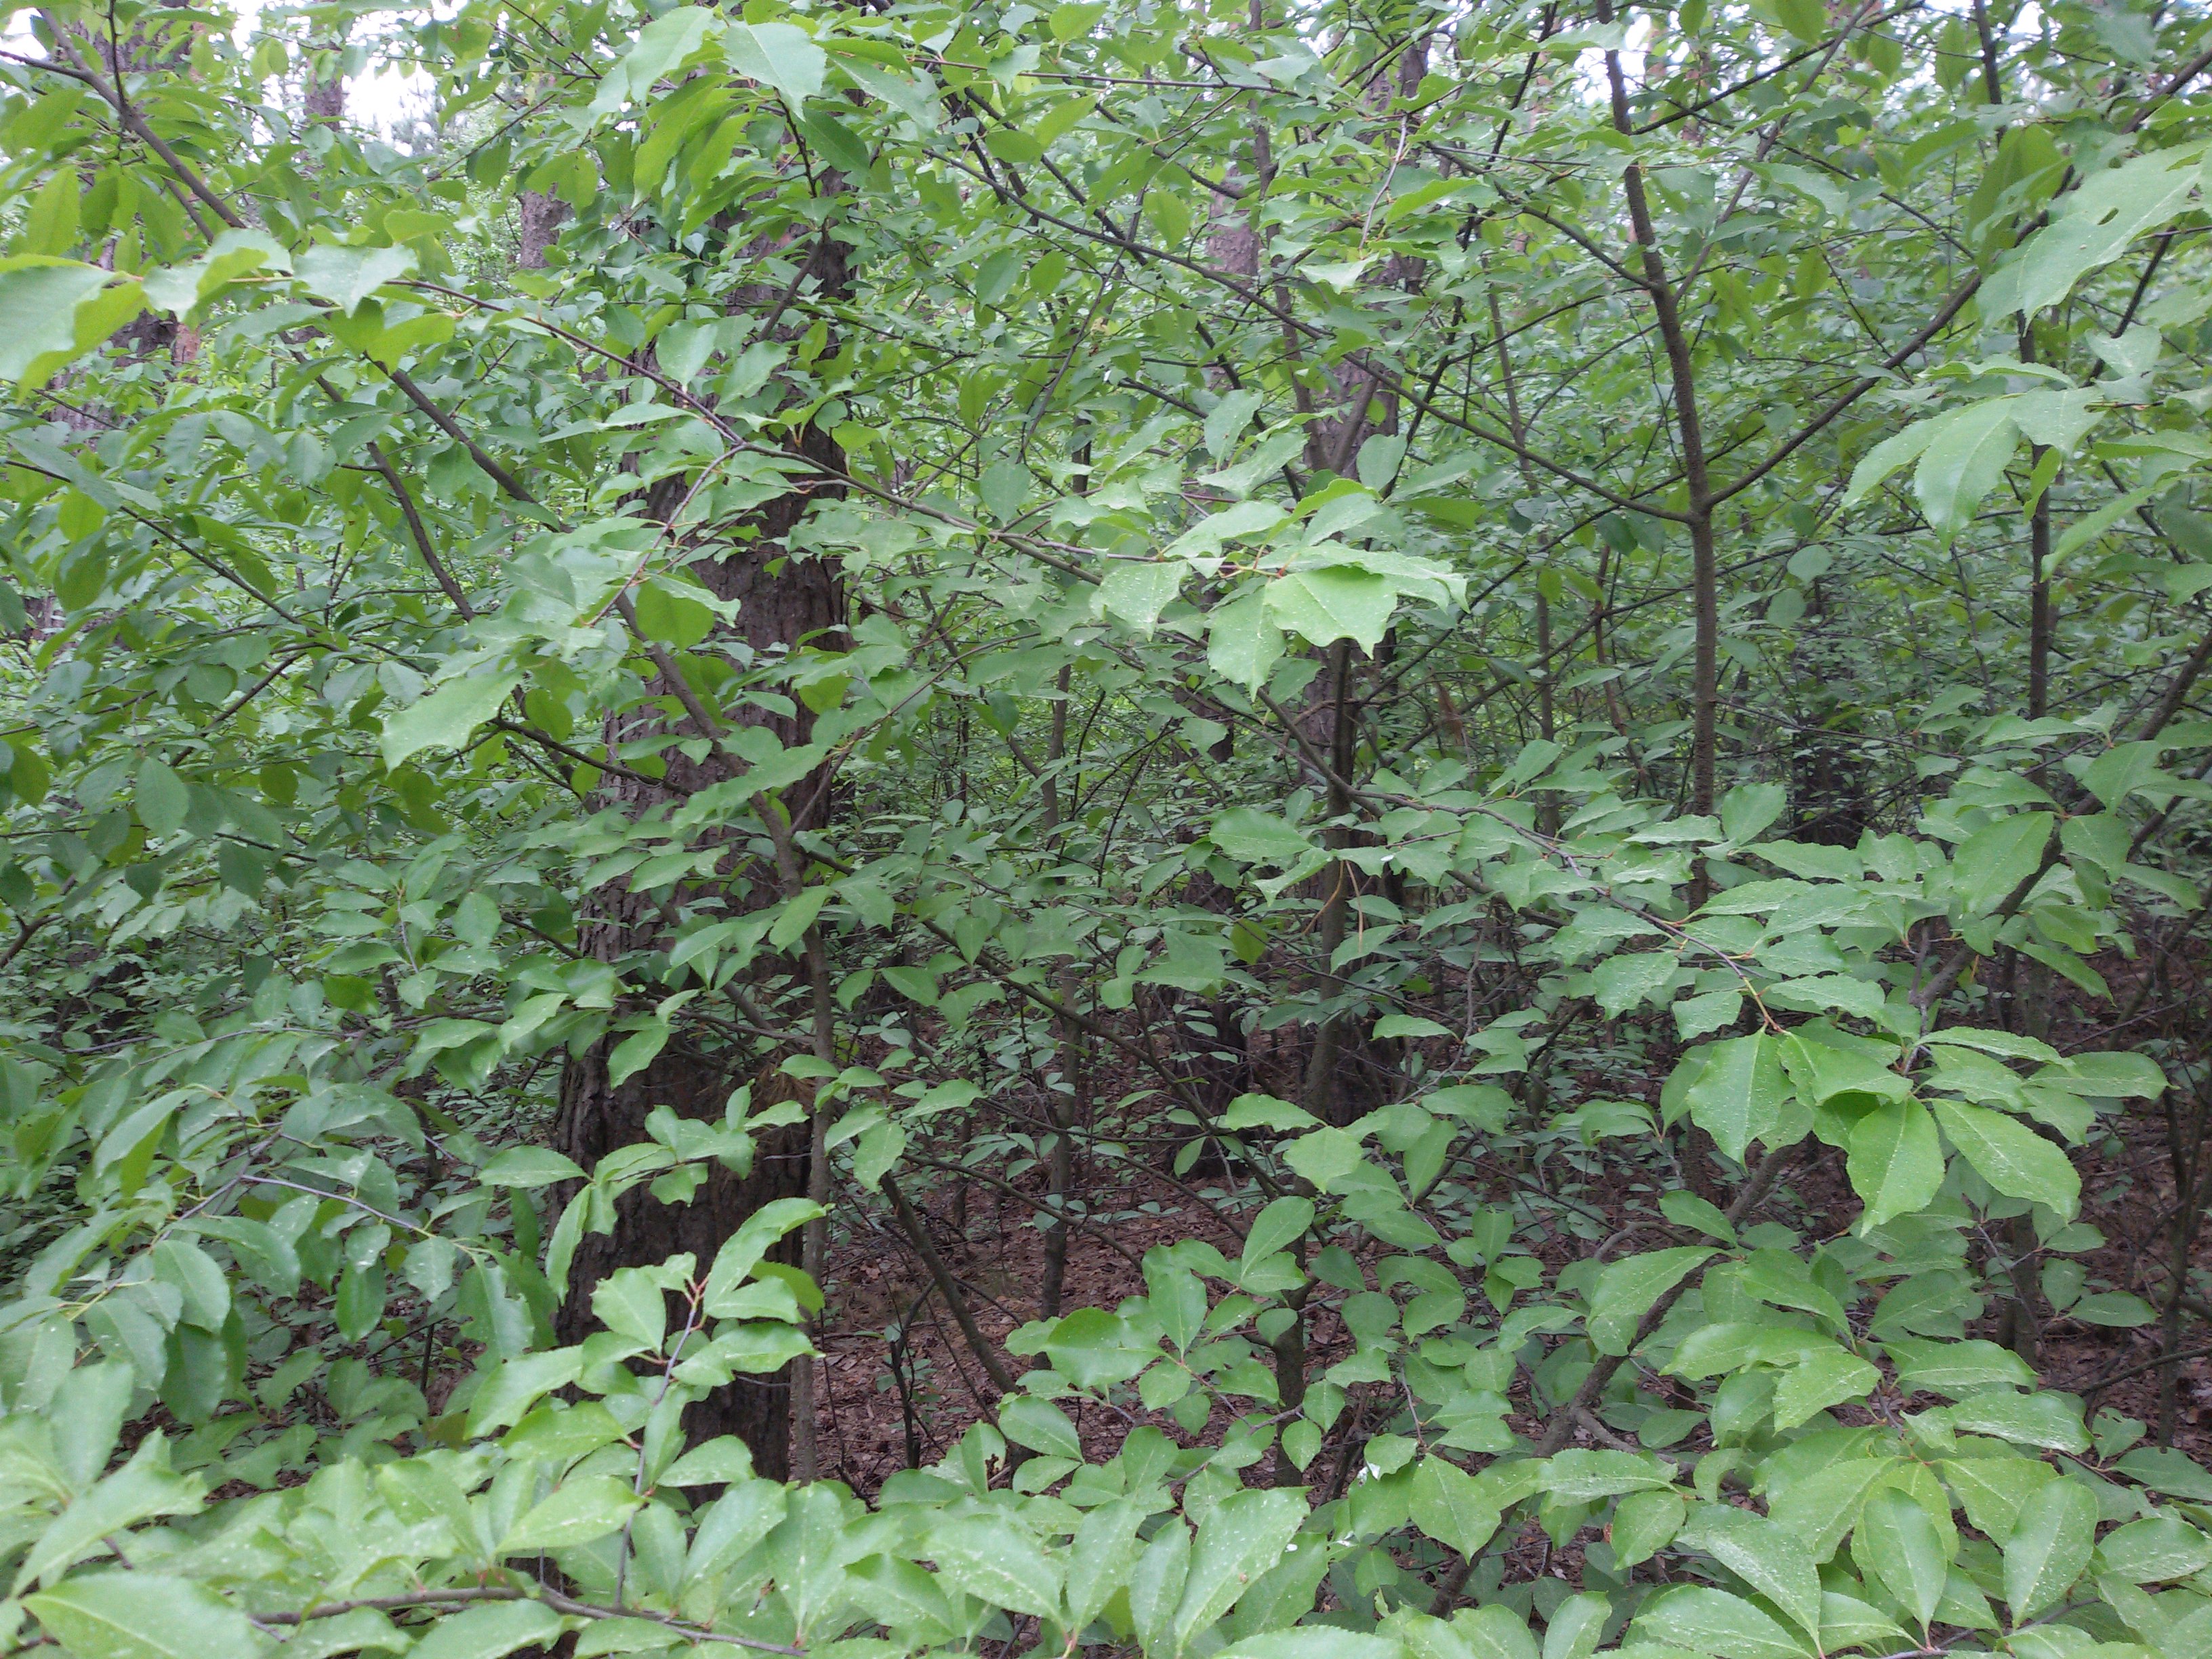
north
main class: Woodland
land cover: Pine dominated coniferous woodland
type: hemiboreal forest and nemoral coniferous forest and mixed broadleaved-coniferous forest
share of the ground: > 75 %
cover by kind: coniferous forest trees 80 %, shrubs 20 %
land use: Forestry
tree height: > 5 m
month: May
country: PL
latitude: 52.6134
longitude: 17.1438
